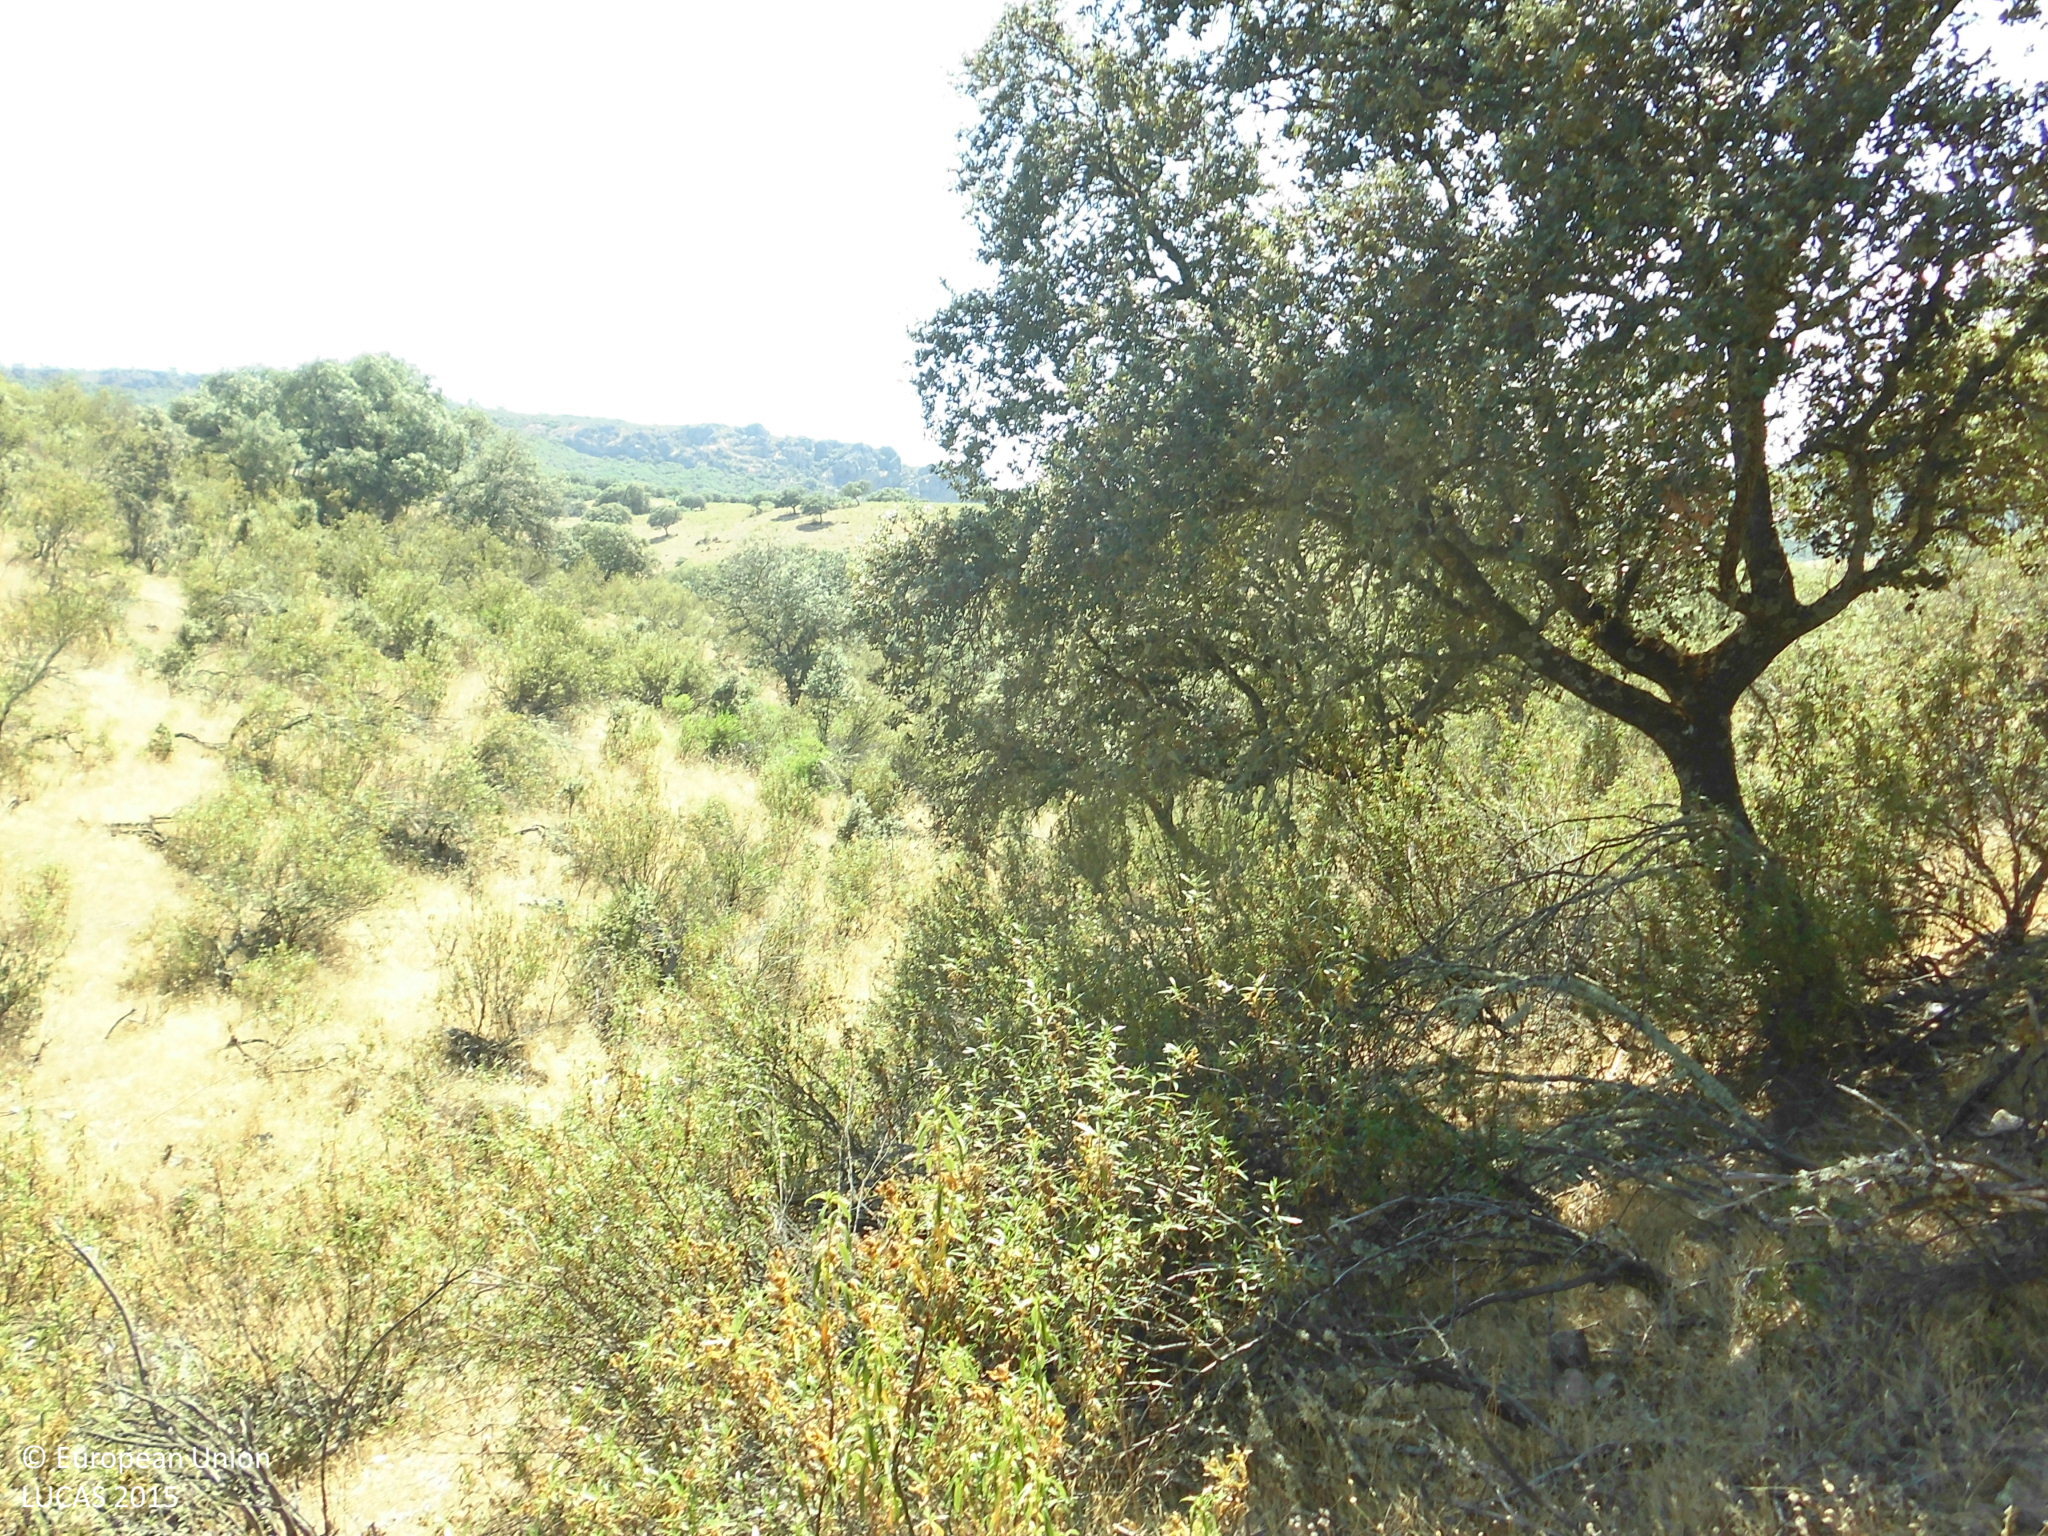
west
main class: Woodland
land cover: Broadleaved woodland
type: broadleaved evergreen forest
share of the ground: 10 - 25 %
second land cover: Shrubland without tree cover
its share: > 75 %
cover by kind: herbaceous plants 60 %, shrubs 25 %, broadleaved forest trees 15 %
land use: Forestry
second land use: Agriculture (excluding fallow land and kitchen gardens)
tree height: > 5 m
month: May
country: ES
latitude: 39.9109
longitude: -6.7053
